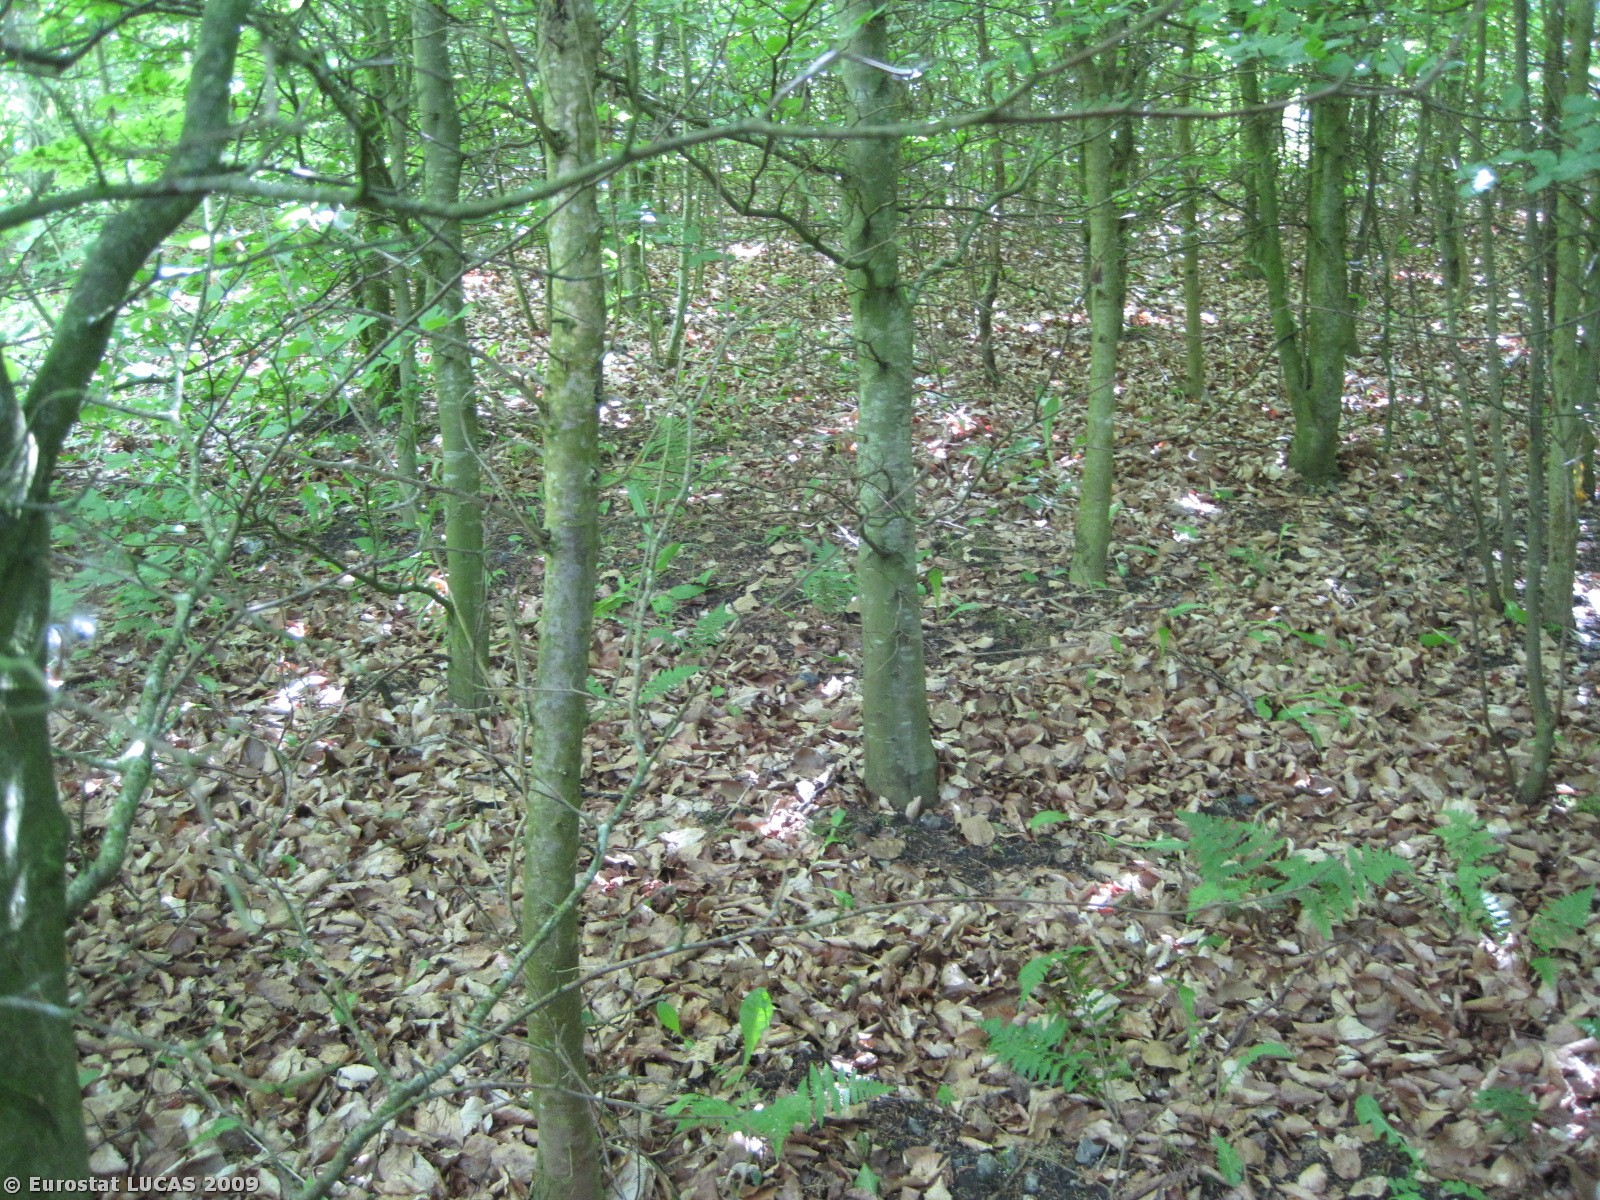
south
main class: Woodland
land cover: Broadleaved woodland
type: beech forest
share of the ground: > 75 %
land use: Forestry
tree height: > 5 m
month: May
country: DK
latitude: 56.5830
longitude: 9.7886
